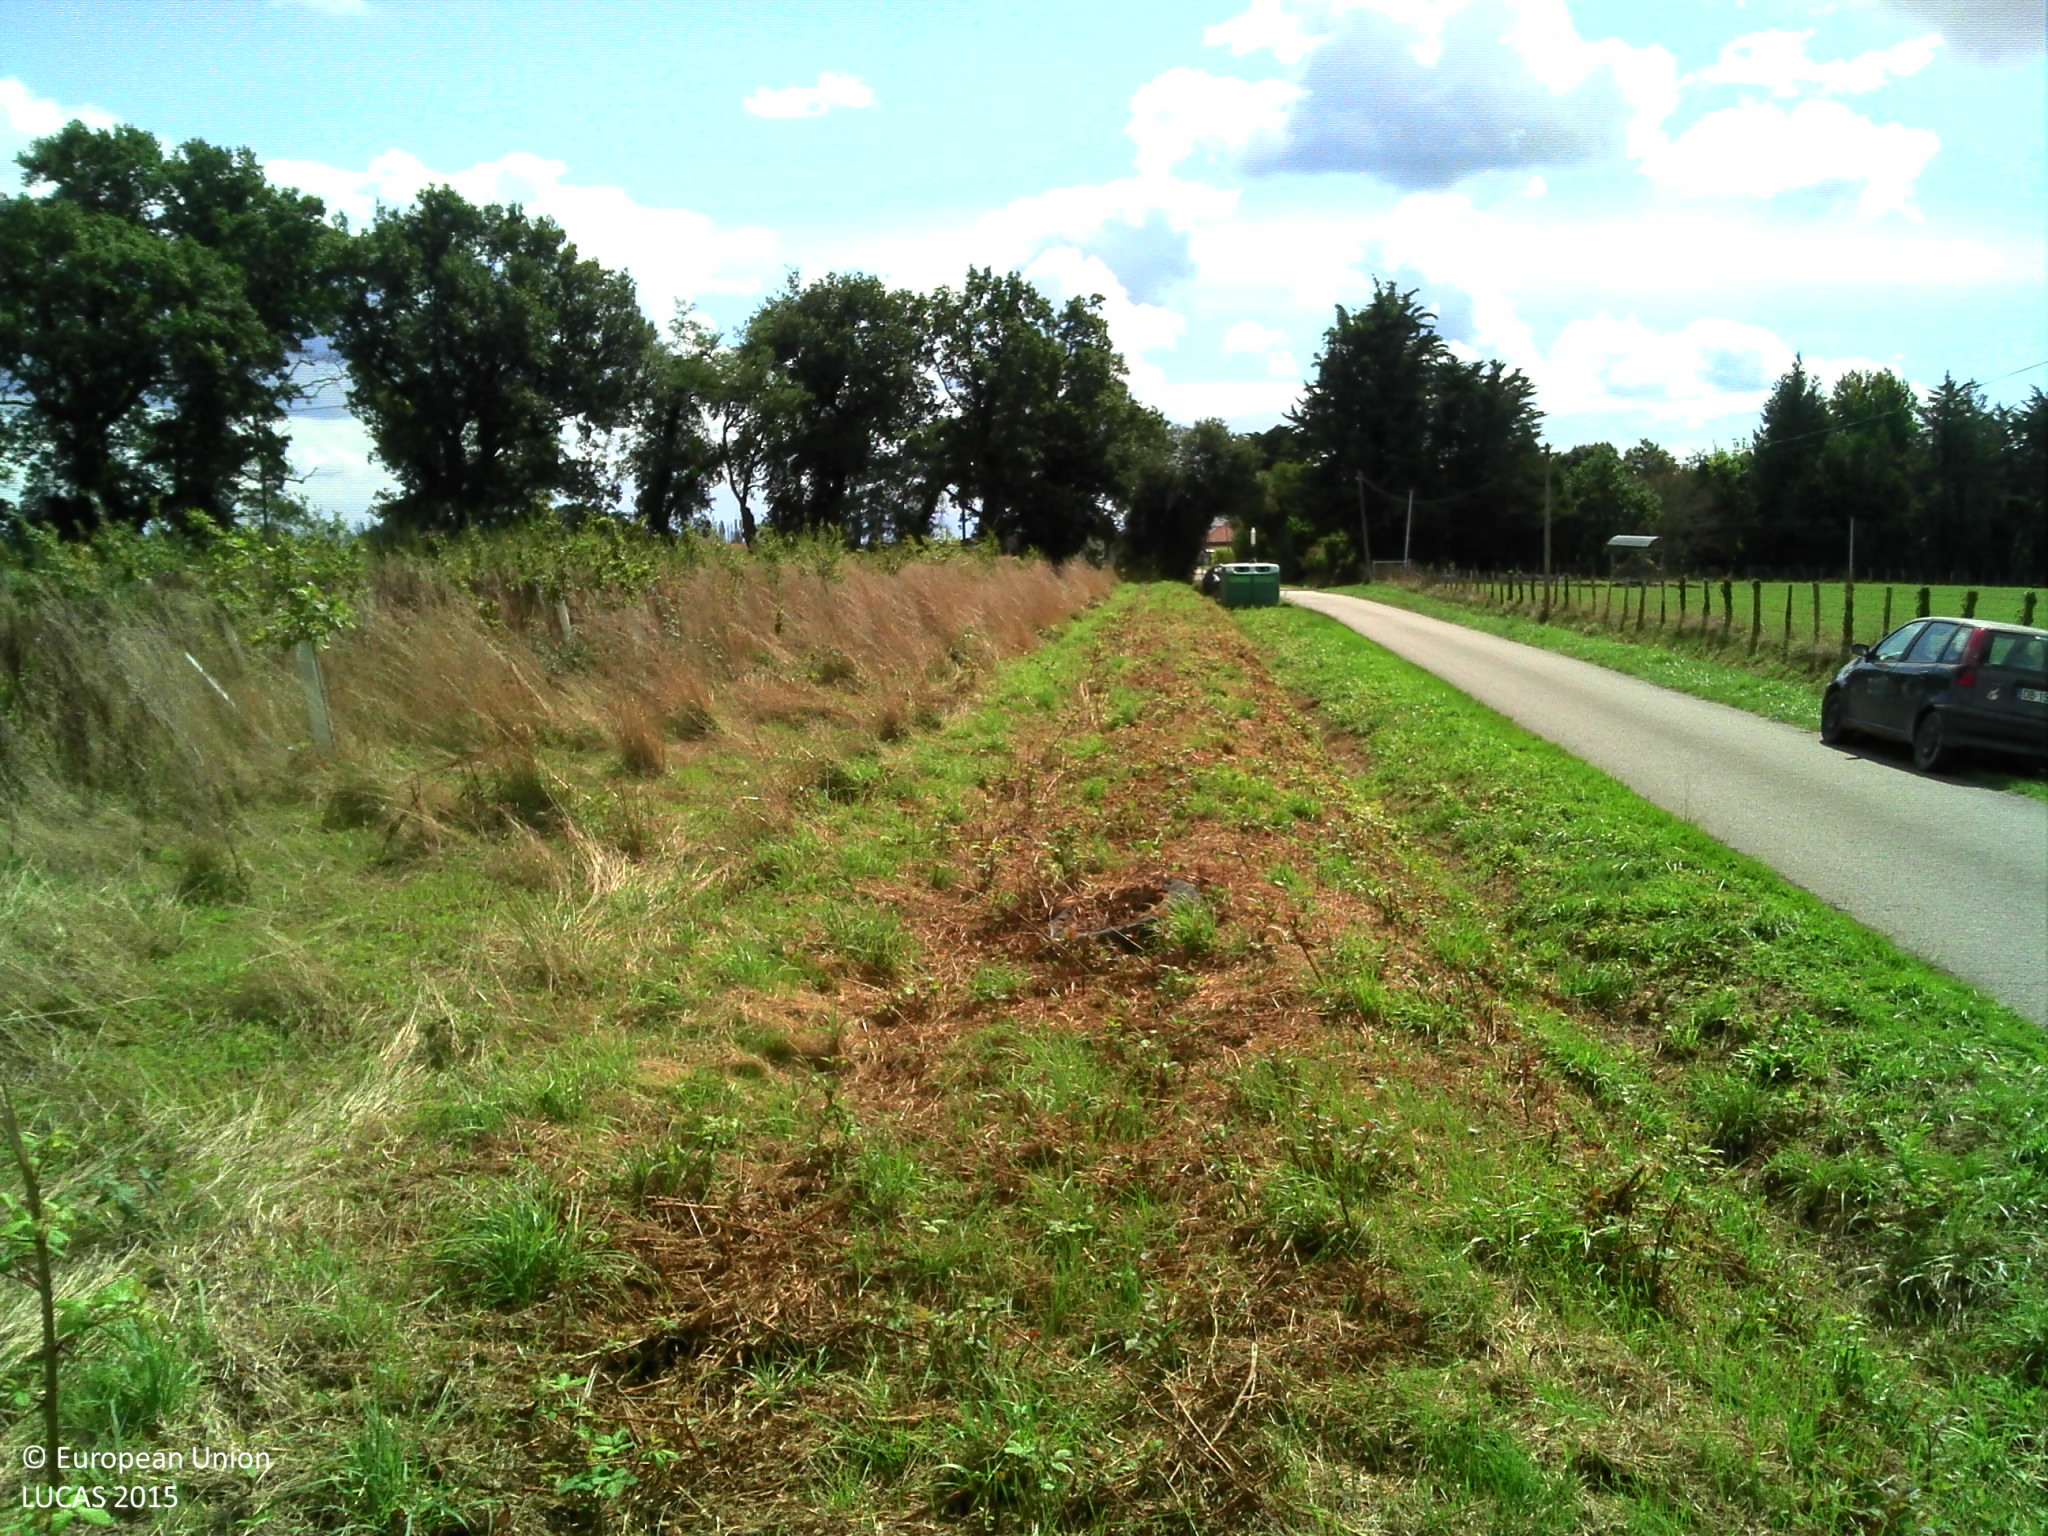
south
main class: Grassland
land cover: Spontaneously vegetated surfaces
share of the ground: > 75 %
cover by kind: herbaceous plants 95 %, shrubs 5 %
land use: Road transport
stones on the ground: < 10 %
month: September
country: FR
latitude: 43.5392
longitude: -0.3667
